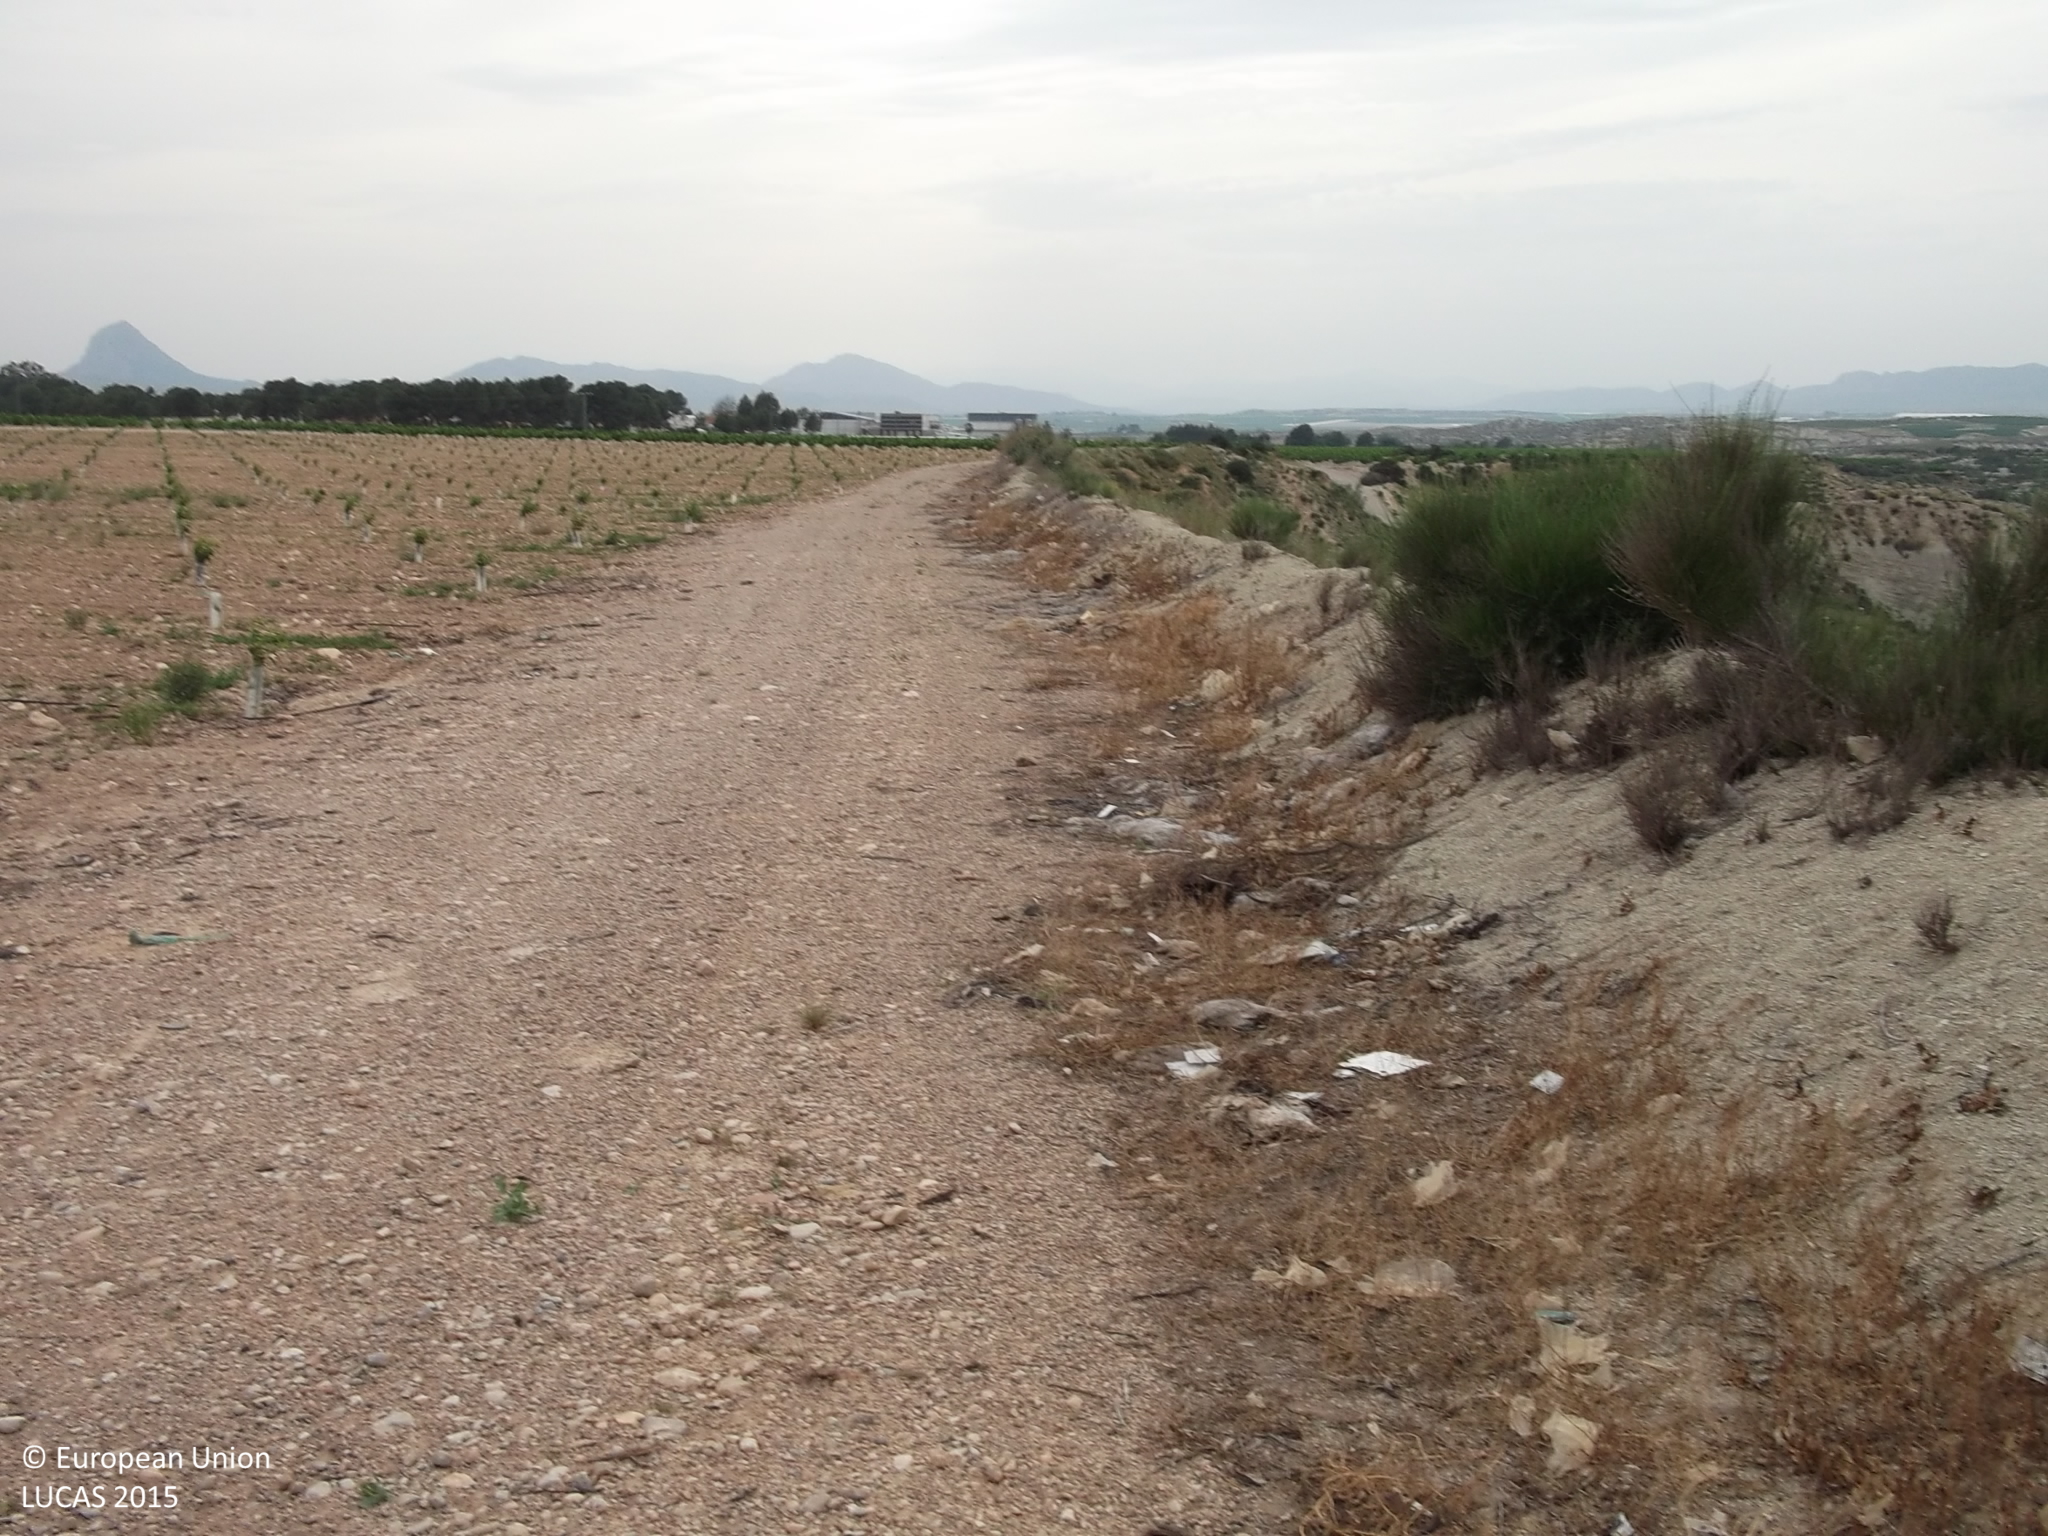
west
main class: Cropland
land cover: Other fruit trees and berries
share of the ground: < 10 %
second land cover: Other bare soil
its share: > 75 %
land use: Agriculture (excluding fallow land and kitchen gardens)
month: May
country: ES
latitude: 38.2840
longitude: -1.4097
